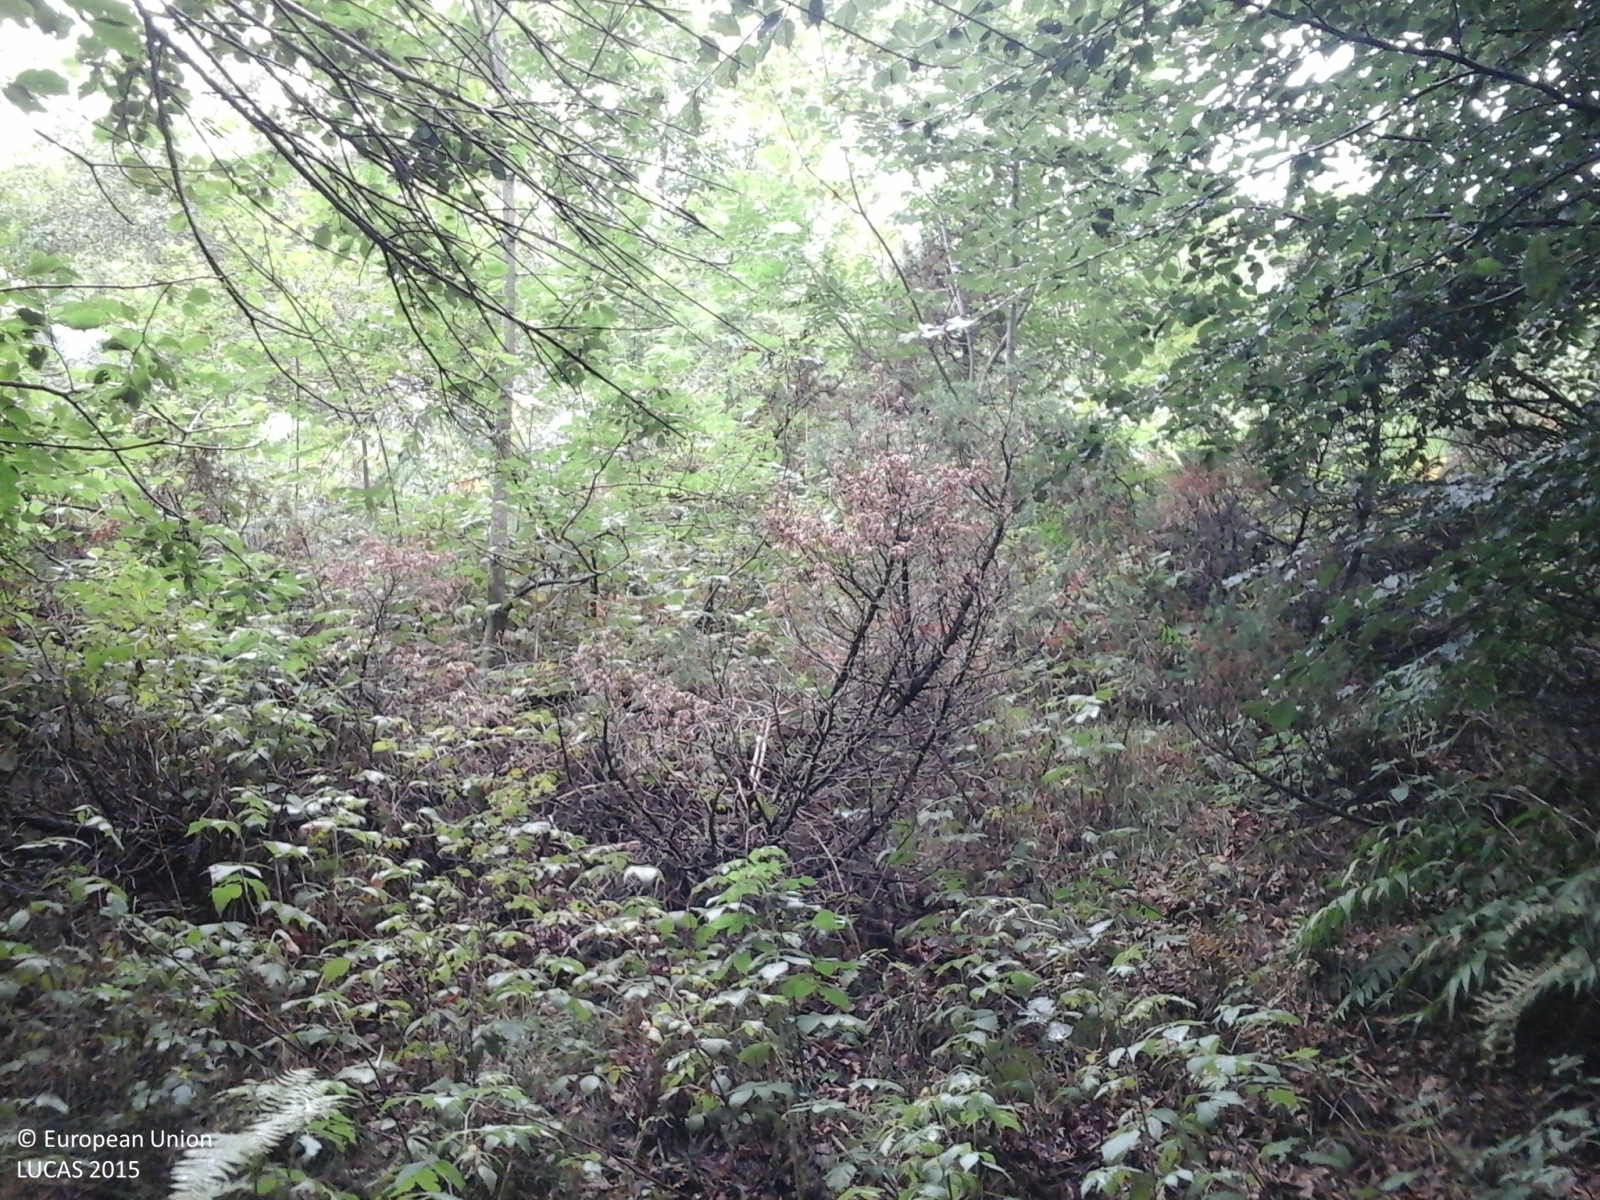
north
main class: Woodland
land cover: Broadleaved woodland
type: mountainous beech forest
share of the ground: > 75 %
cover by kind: broadleaved forest trees 80 %, coniferous forest trees 10 %, herbaceous plants 10 %
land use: Forestry
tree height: > 5 m
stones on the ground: < 10 %
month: August
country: IT
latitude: 46.0773
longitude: 9.1091
